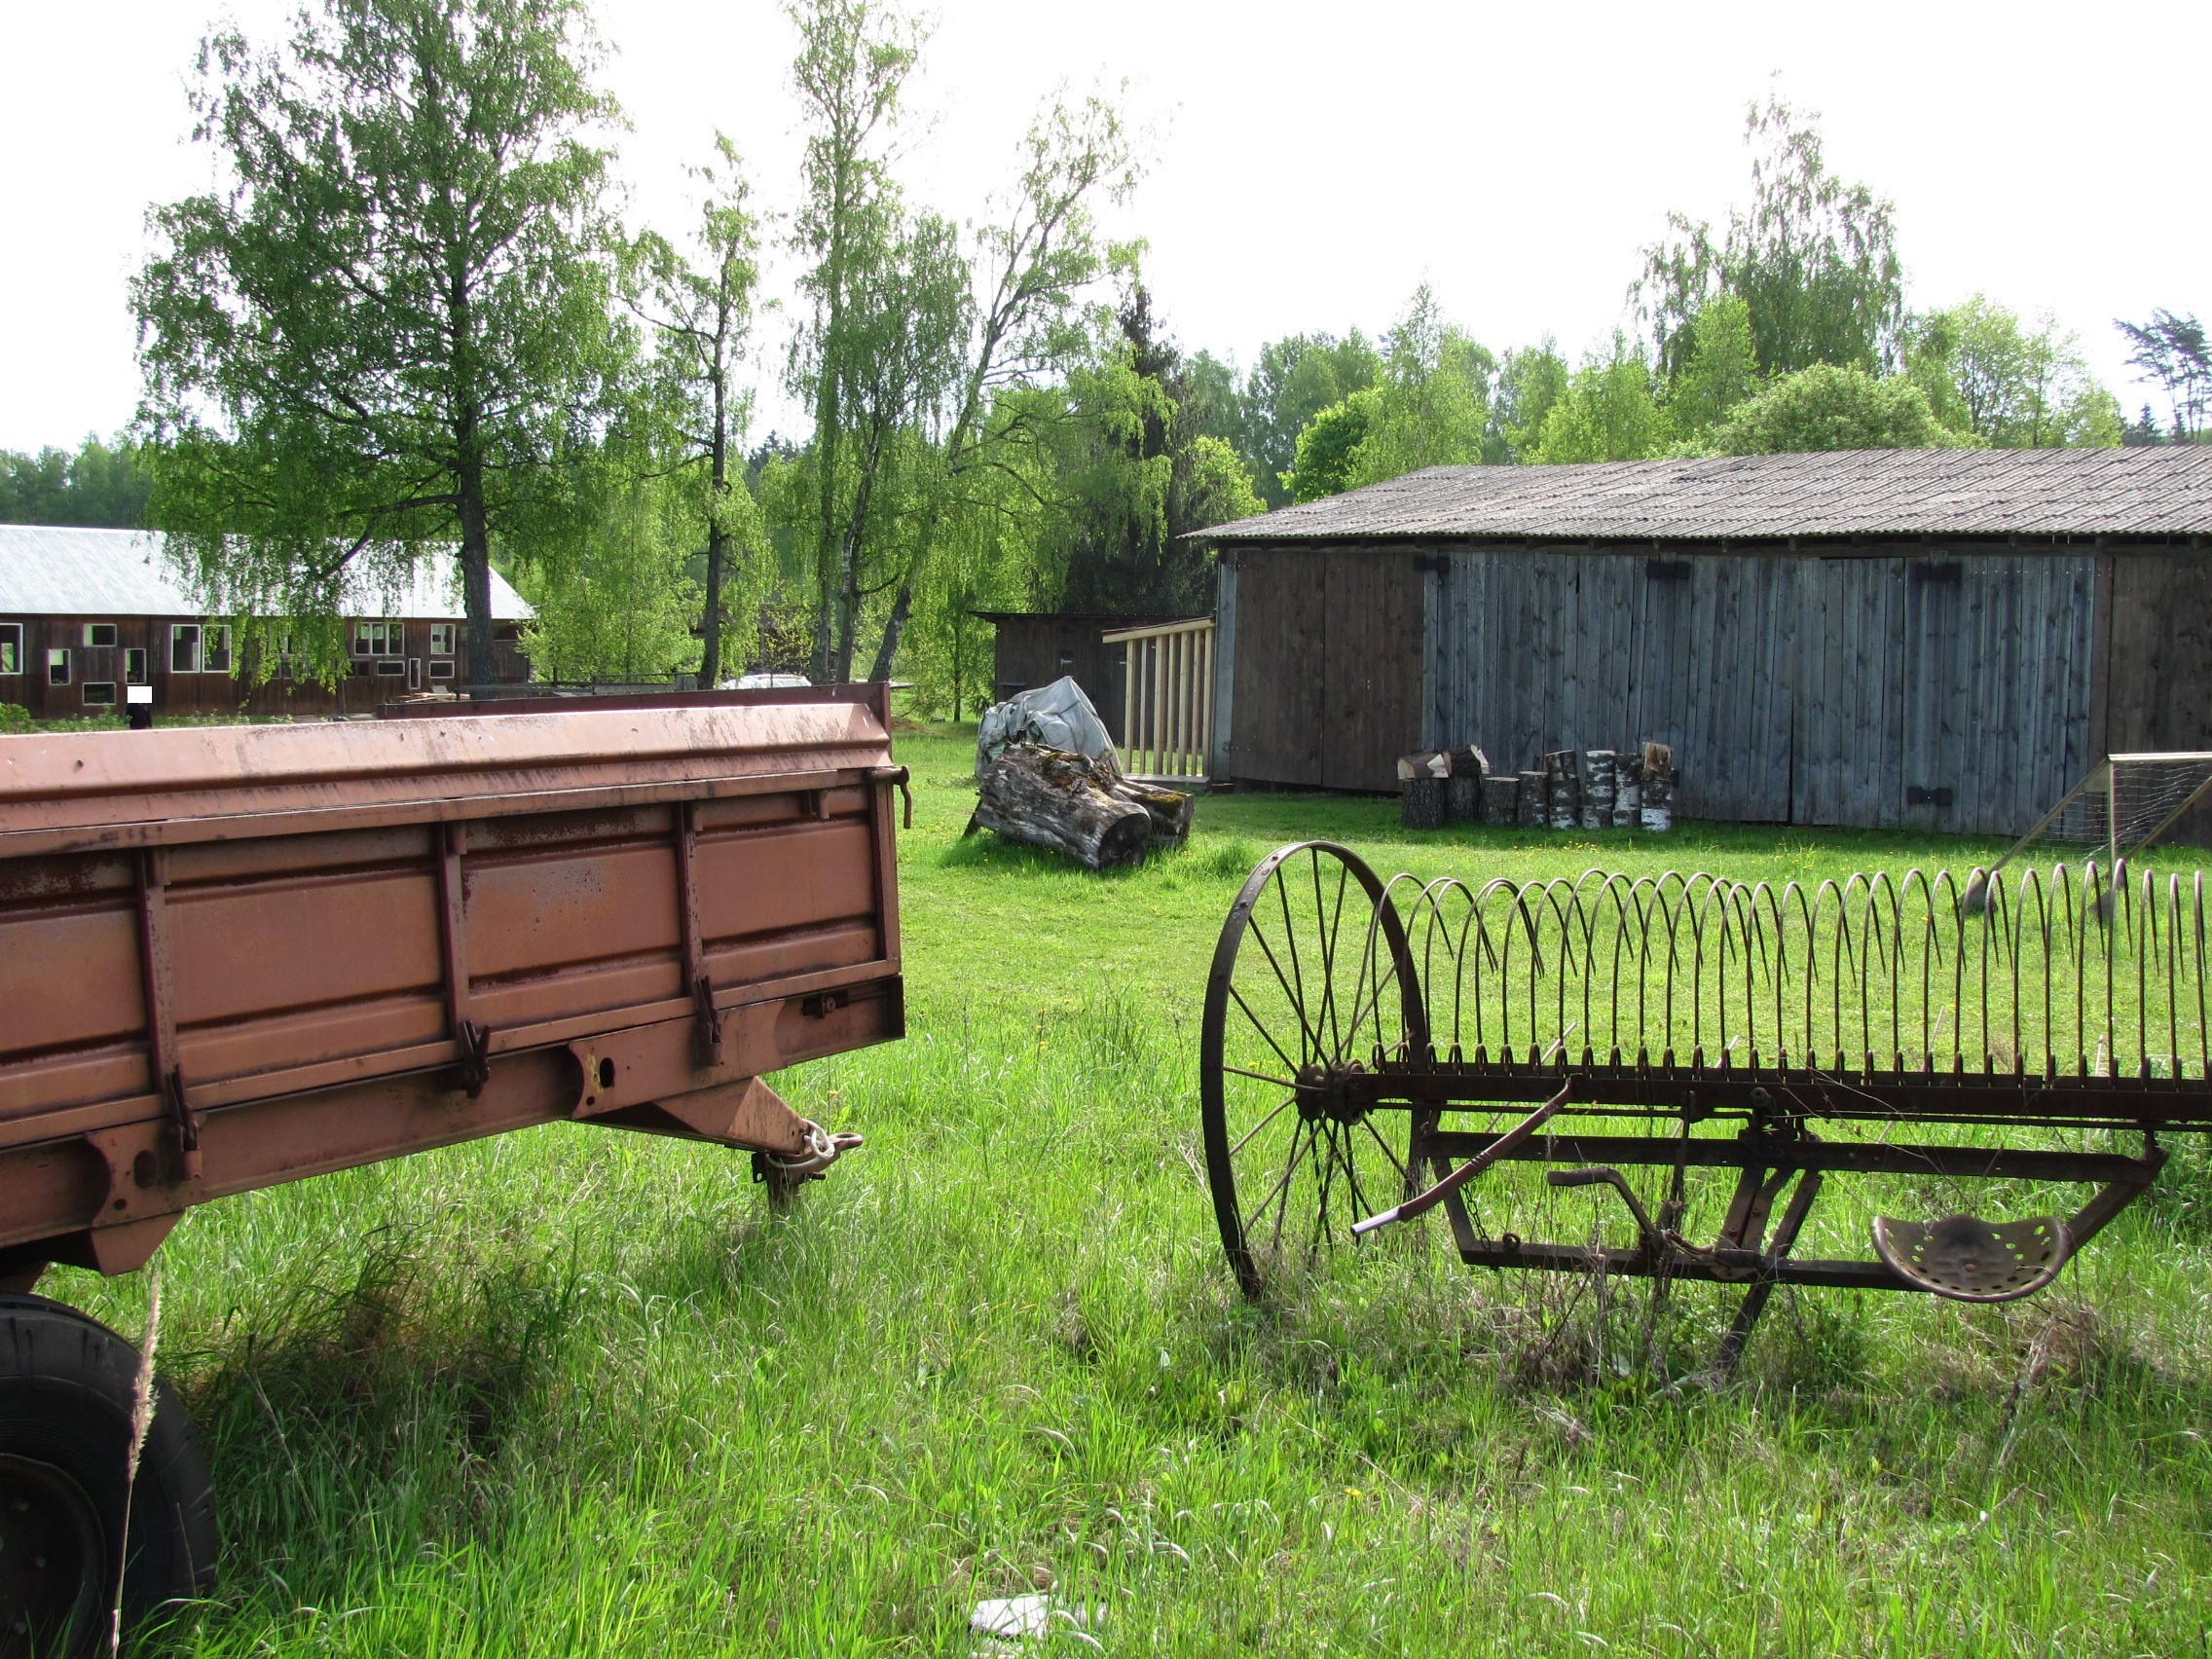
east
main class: Grassland
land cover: Grassland without tree/shrub cover
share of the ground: > 75 %
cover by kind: herbaceous plants 100 %
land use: Agriculture (excluding fallow land and kitchen gardens)
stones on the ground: < 10 %
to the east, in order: Grassland without tree/shrub cover; Artificial constructions in urban areas; Grassland without tree/shrub cover; Broadleaved woodland; Ditches and canals; Broadleaved woodland; Tracks; Grassland with sparse tree/shrub cover
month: May
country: LV
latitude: 56.8022
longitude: 24.3547
